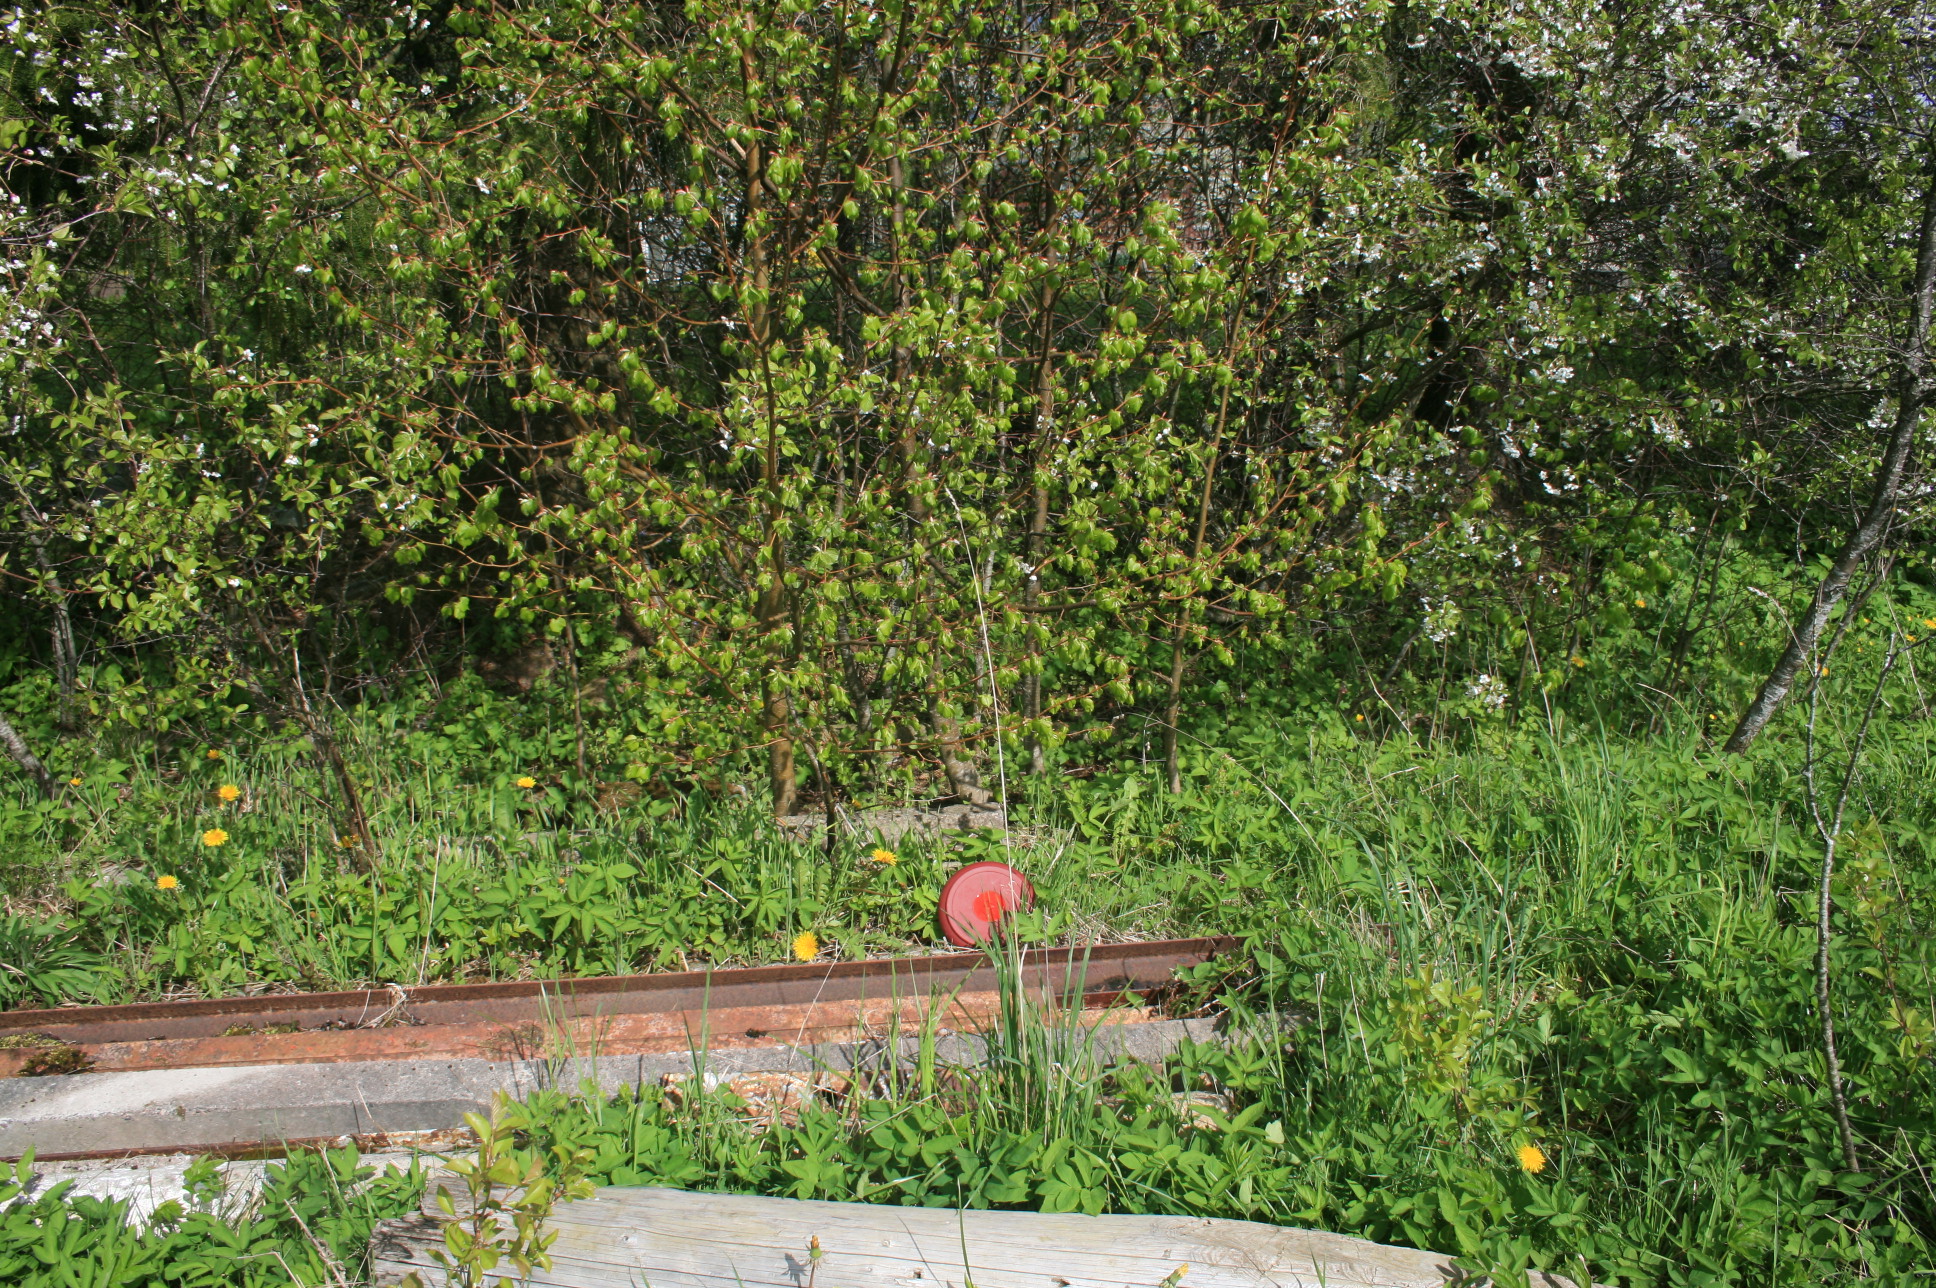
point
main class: Woodland
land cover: Spruce dominated mixed woodland
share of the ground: > 75 %
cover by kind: coniferous forest trees 55 %, broadleaved forest trees 45 %
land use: Residential
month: May
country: LT
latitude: 56.2167
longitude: 22.0648
